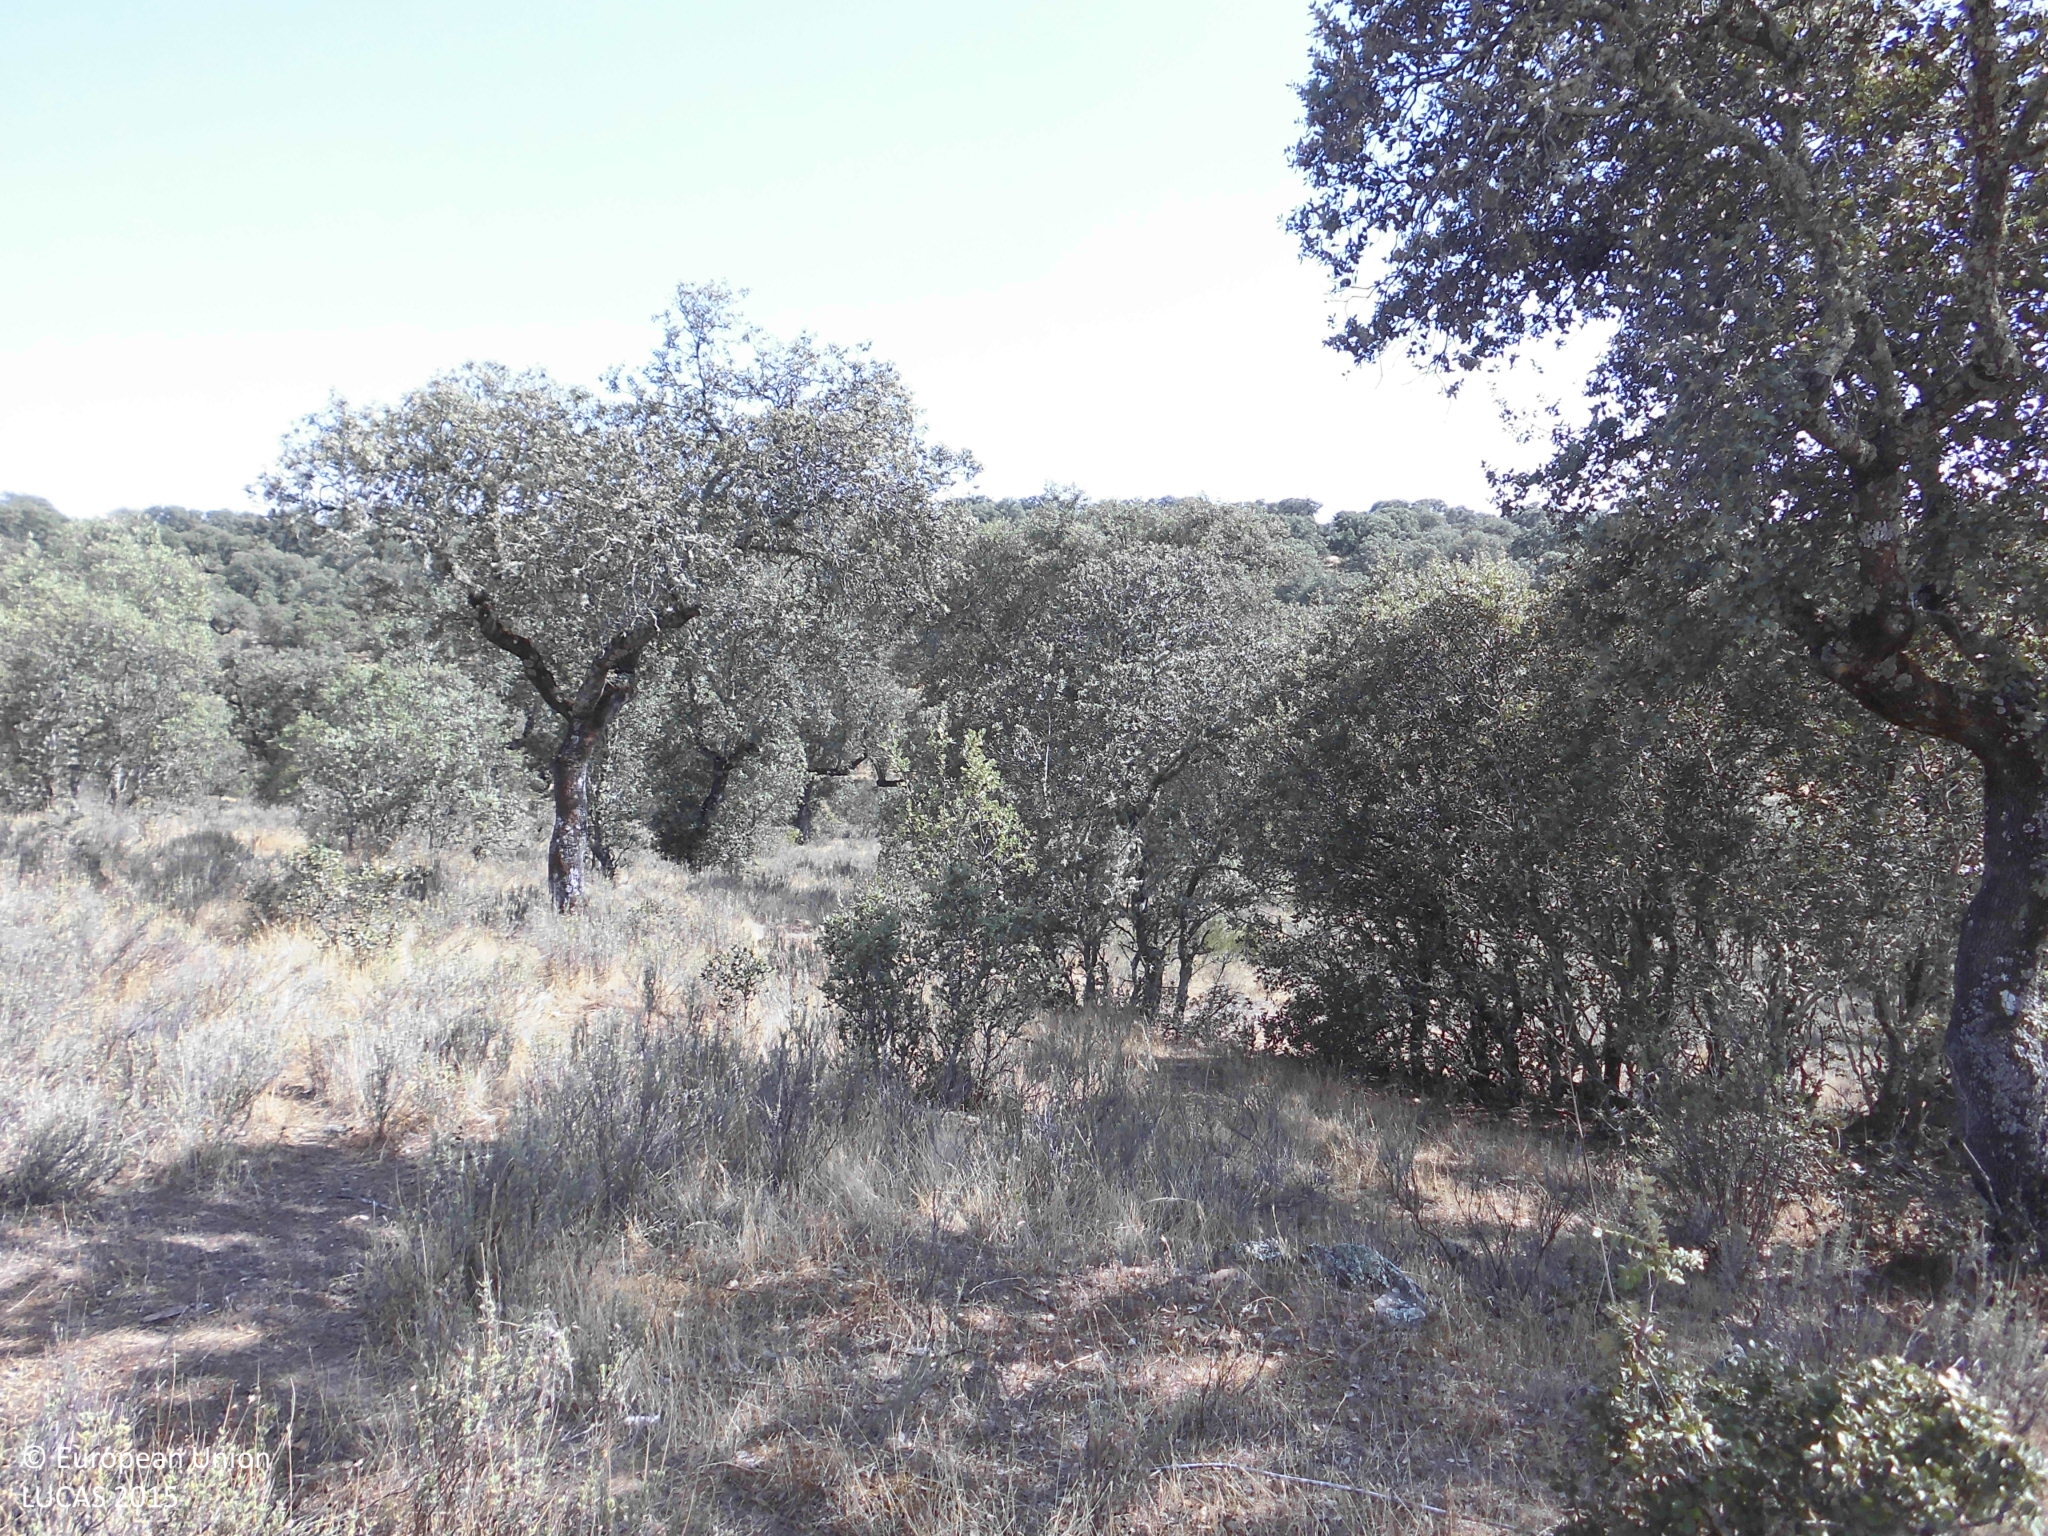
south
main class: Woodland
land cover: Broadleaved woodland
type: broadleaved evergreen forest
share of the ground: 10 - 25 %
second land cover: Grassland without tree/shrub cover
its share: > 75 %
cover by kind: herbaceous plants 65 %, shrubs 20 %, broadleaved forest trees 15 %
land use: Forestry
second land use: Agriculture (excluding fallow land and kitchen gardens)
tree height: > 5 m
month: June
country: ES
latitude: 39.7573
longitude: -6.0929
